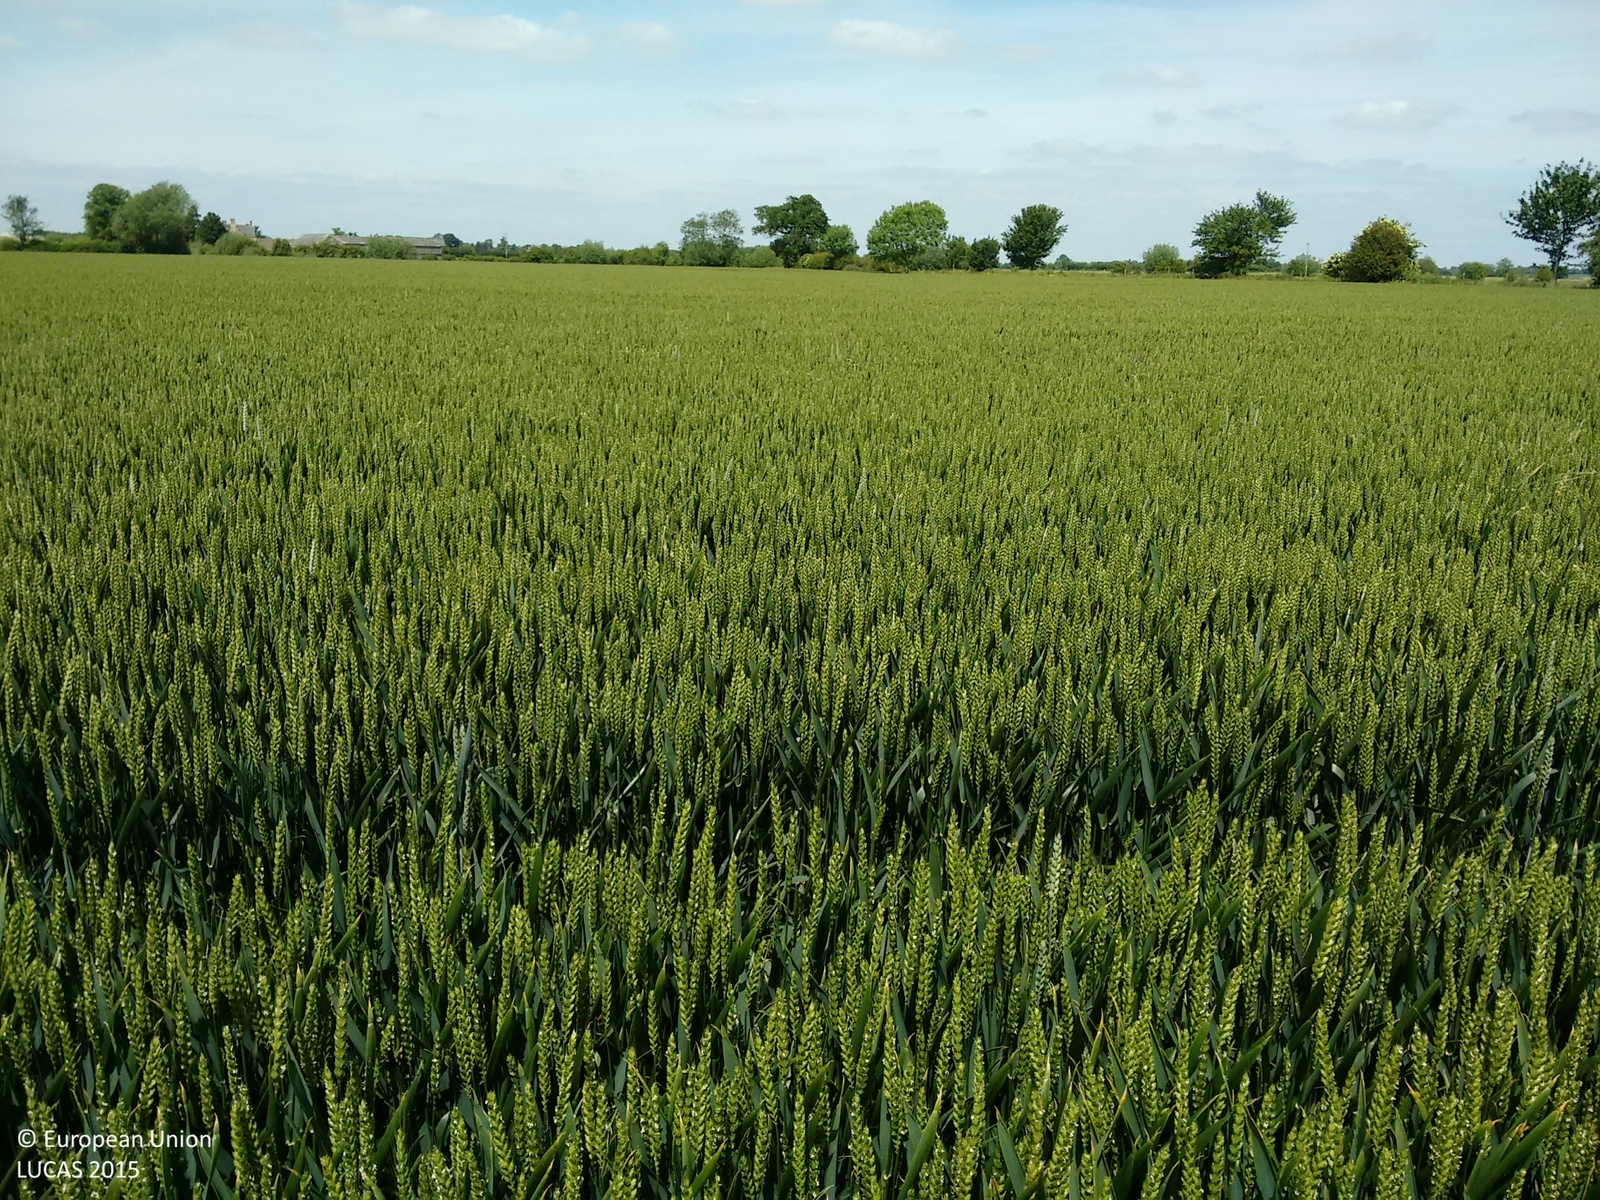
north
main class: Cropland
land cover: Common wheat
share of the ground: > 75 %
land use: Agriculture (excluding fallow land and kitchen gardens)
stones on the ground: < 10 %
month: June
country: GB
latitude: 51.8037
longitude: -1.2581
